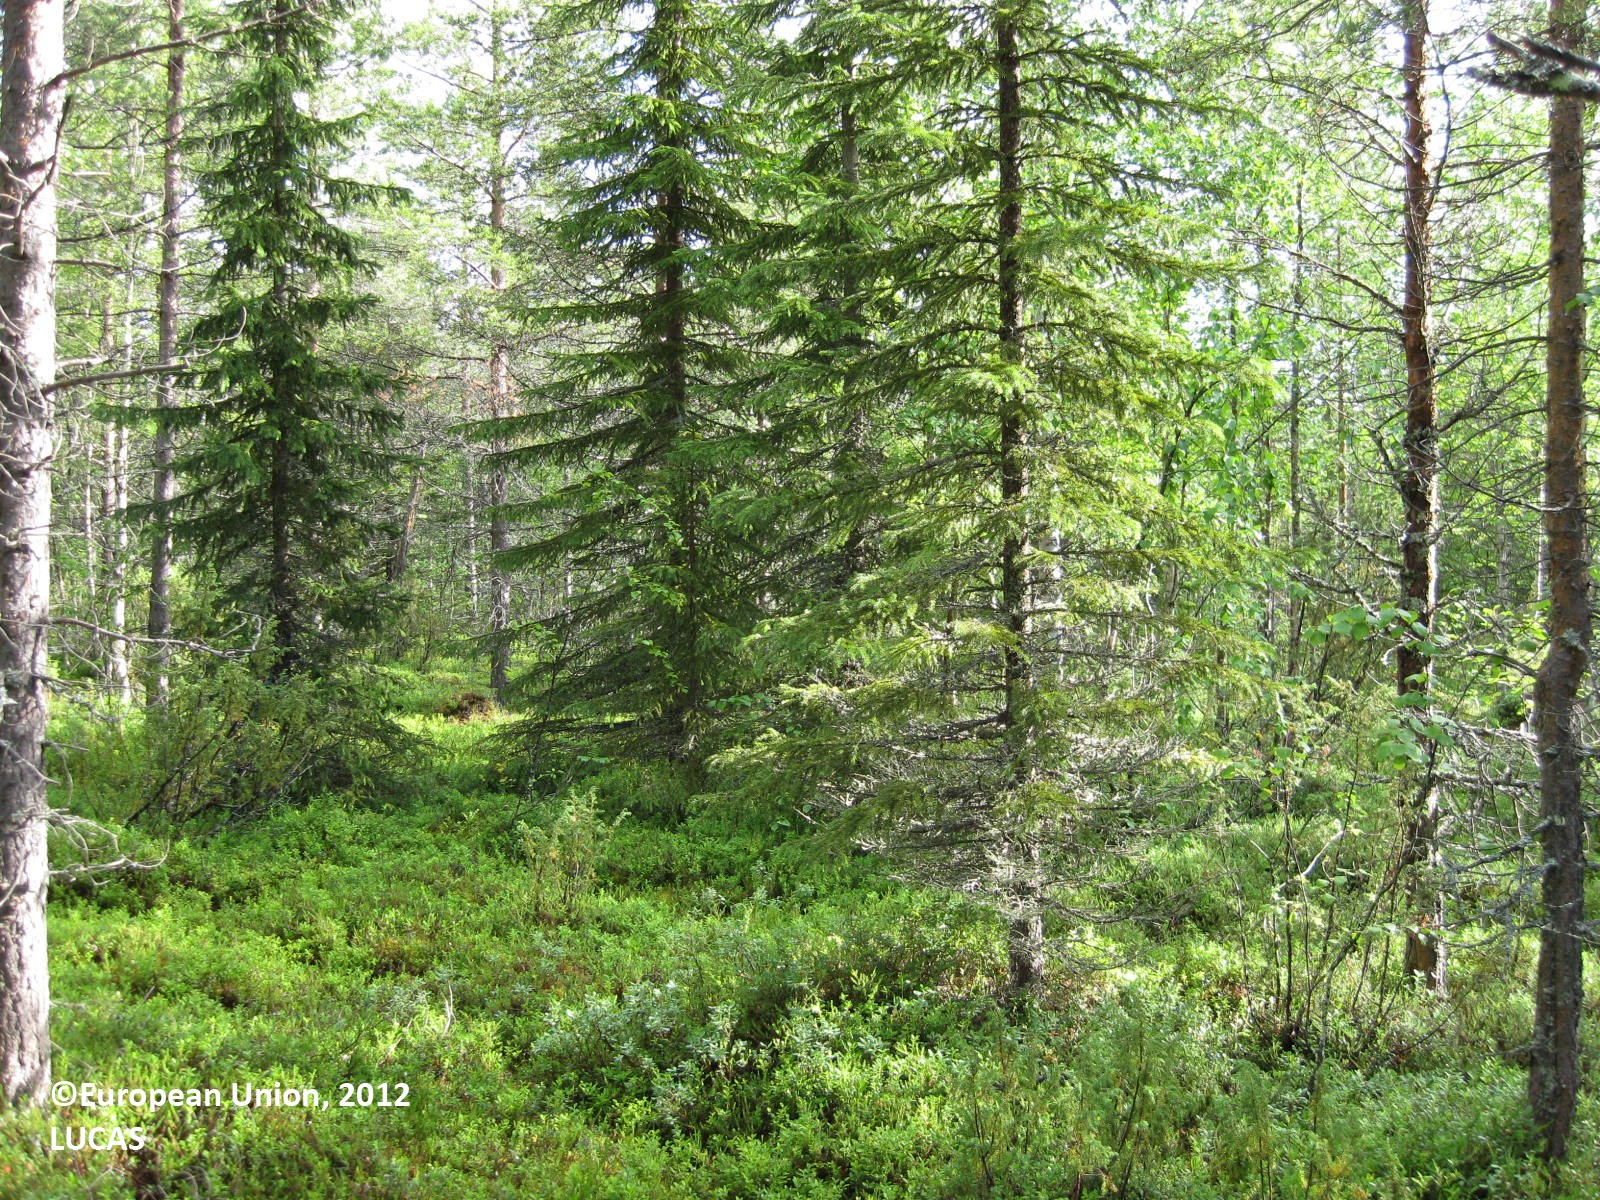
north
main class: Woodland
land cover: Pine dominated mixed woodland
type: boreal forest
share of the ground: > 75 %
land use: Forestry
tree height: > 5 m
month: July
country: FI
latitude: 65.6924
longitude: 29.4163
